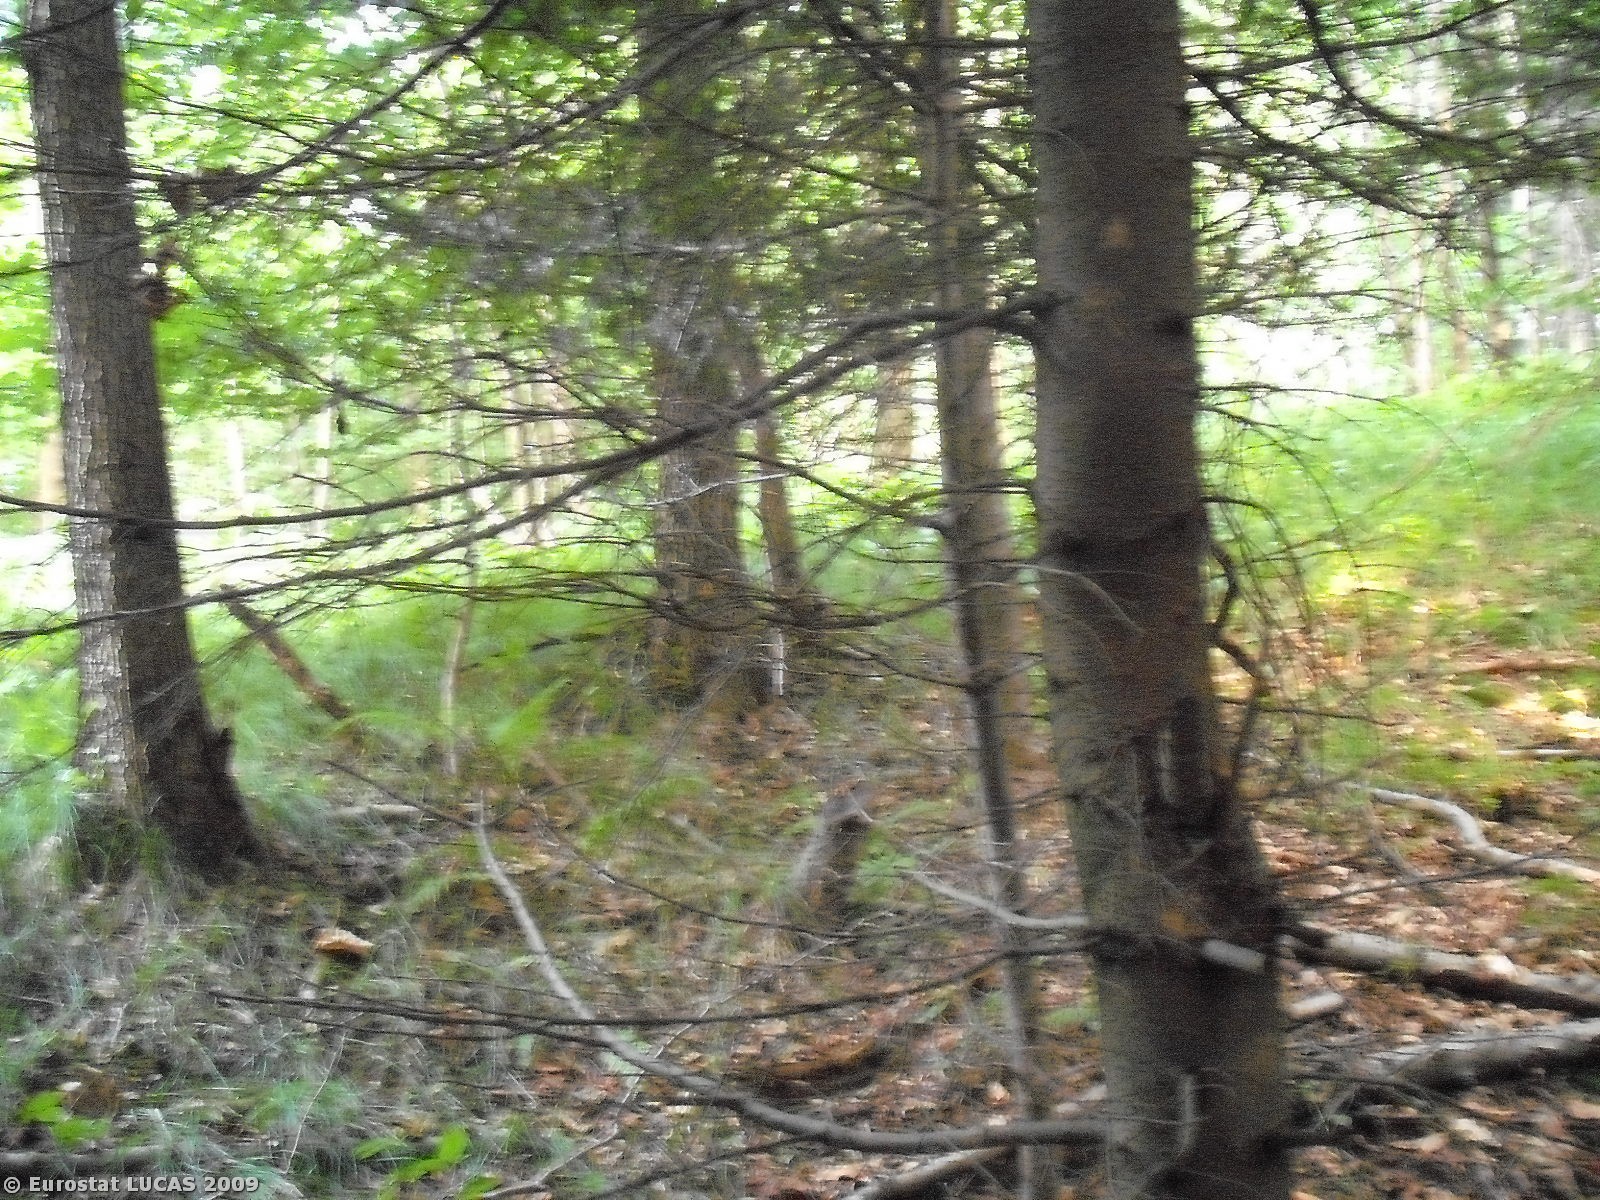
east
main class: Woodland
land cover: Mixed woodland
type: hemiboreal forest and nemoral coniferous forest and mixed broadleaved-coniferous forest
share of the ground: > 75 %
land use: Forestry
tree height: > 5 m
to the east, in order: Mixed woodland; Broadleaved woodland; Ditches and canals; Paved roads, cycling and walking lanes; Ditches and canals; Broadleaved woodland; Mixed woodland; Coniferous woodland
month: July
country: PL
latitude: 49.8982
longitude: 20.2954
